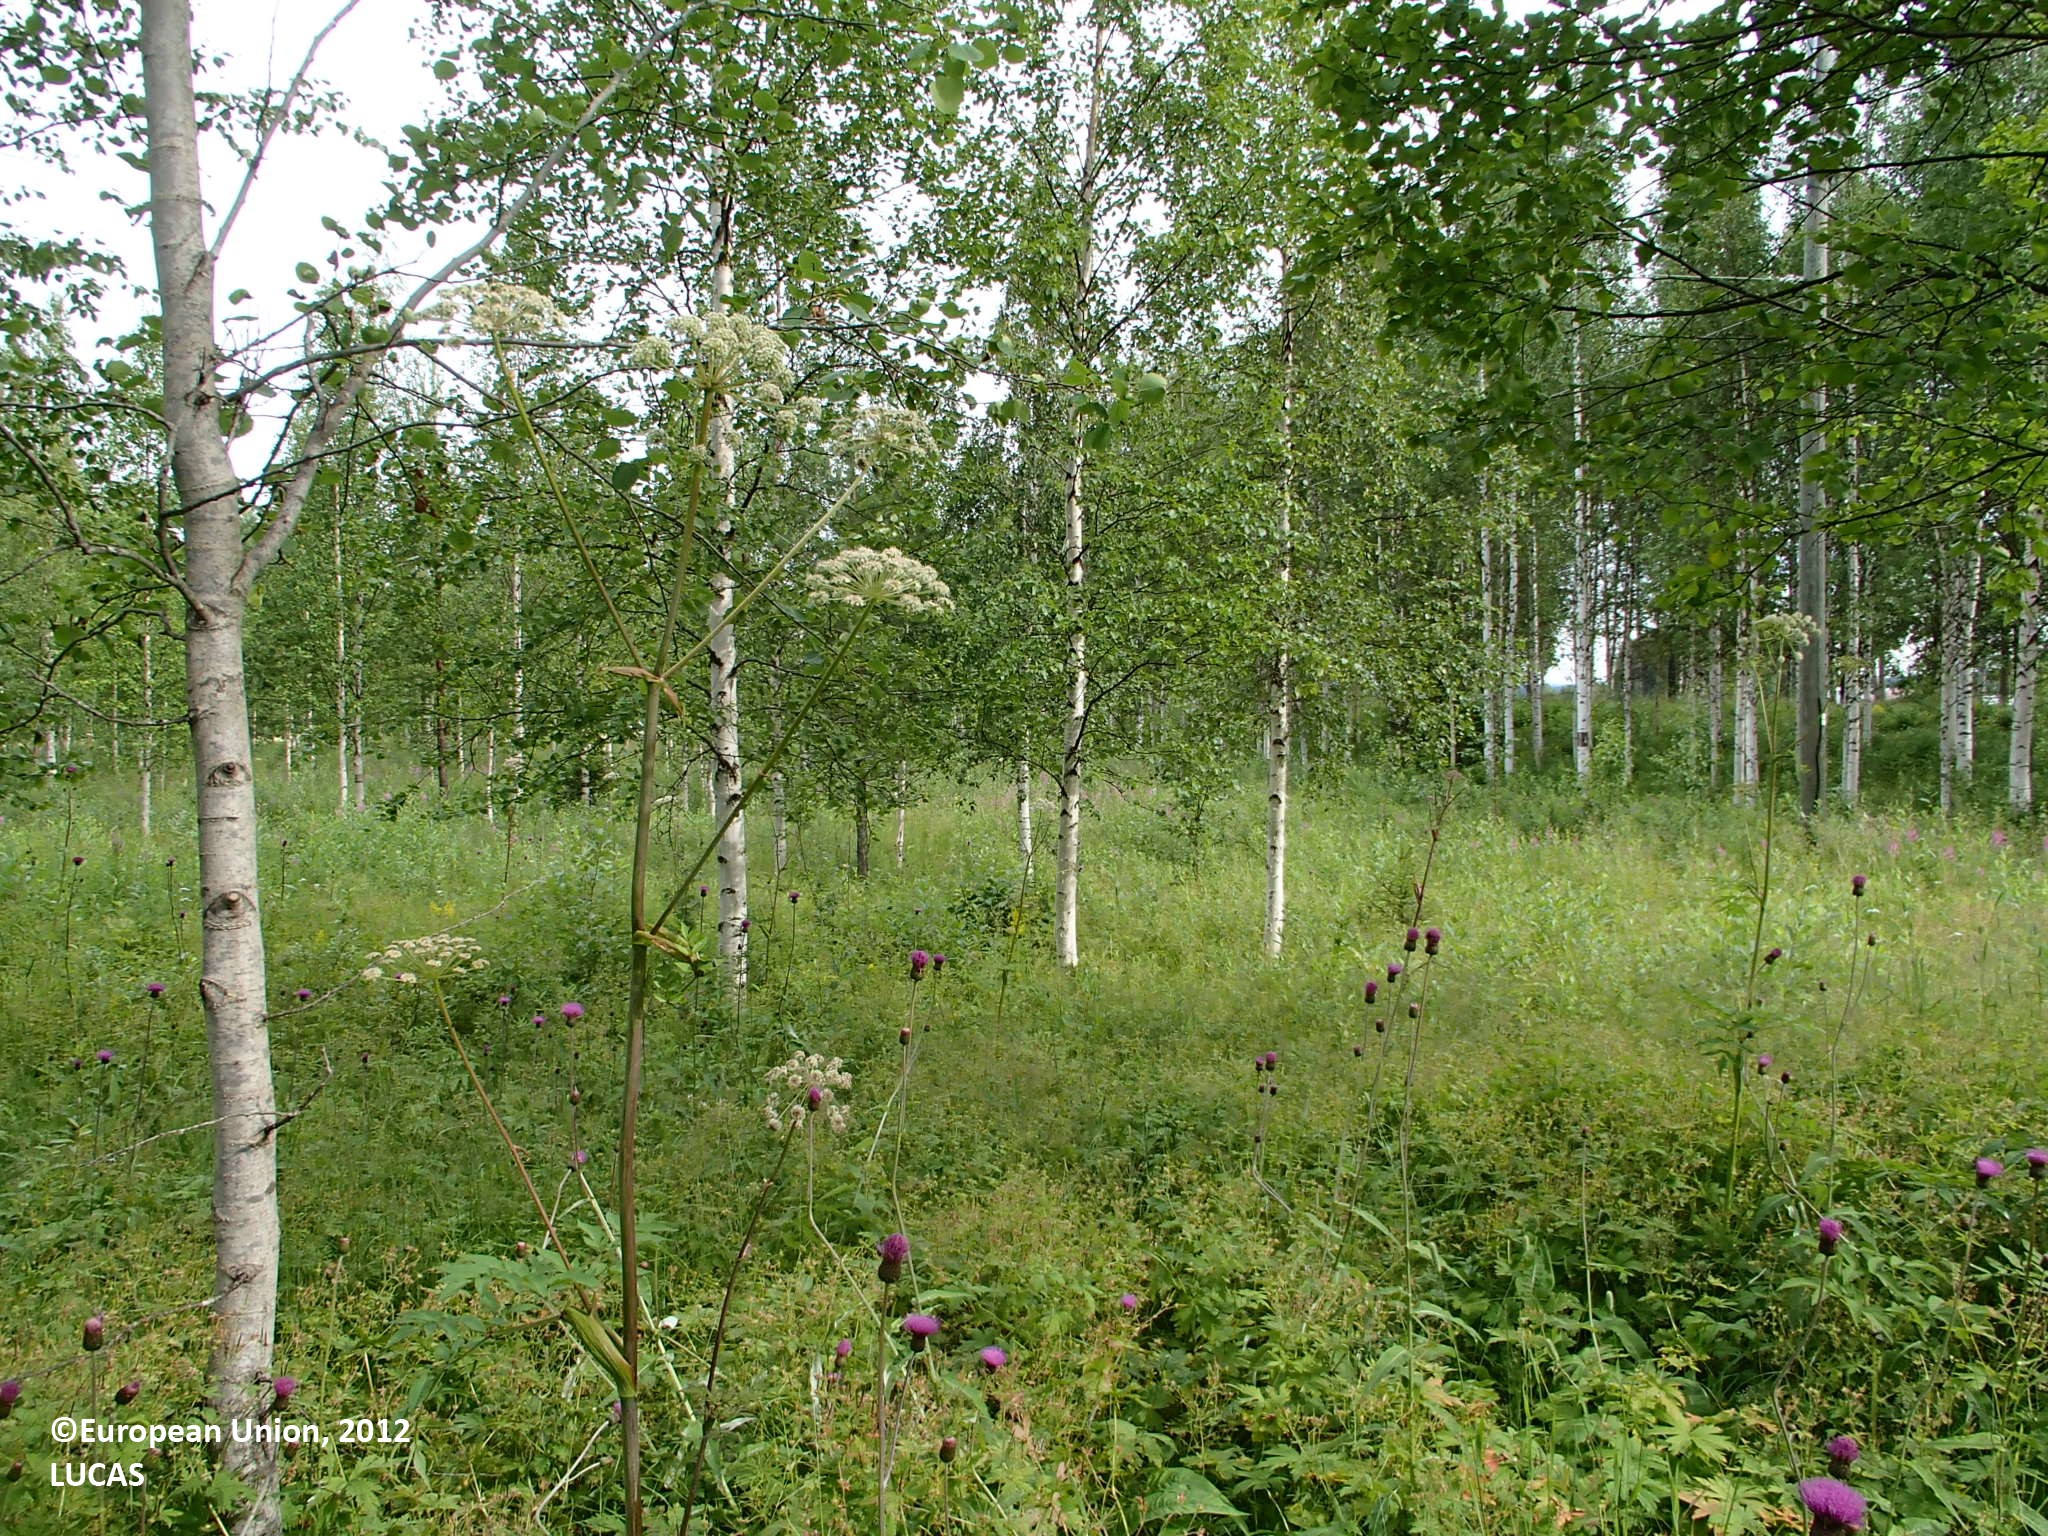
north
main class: Woodland
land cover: Broadleaved woodland
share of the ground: > 75 %
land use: Forestry
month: July
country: FI
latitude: 66.3800
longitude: 25.3842
